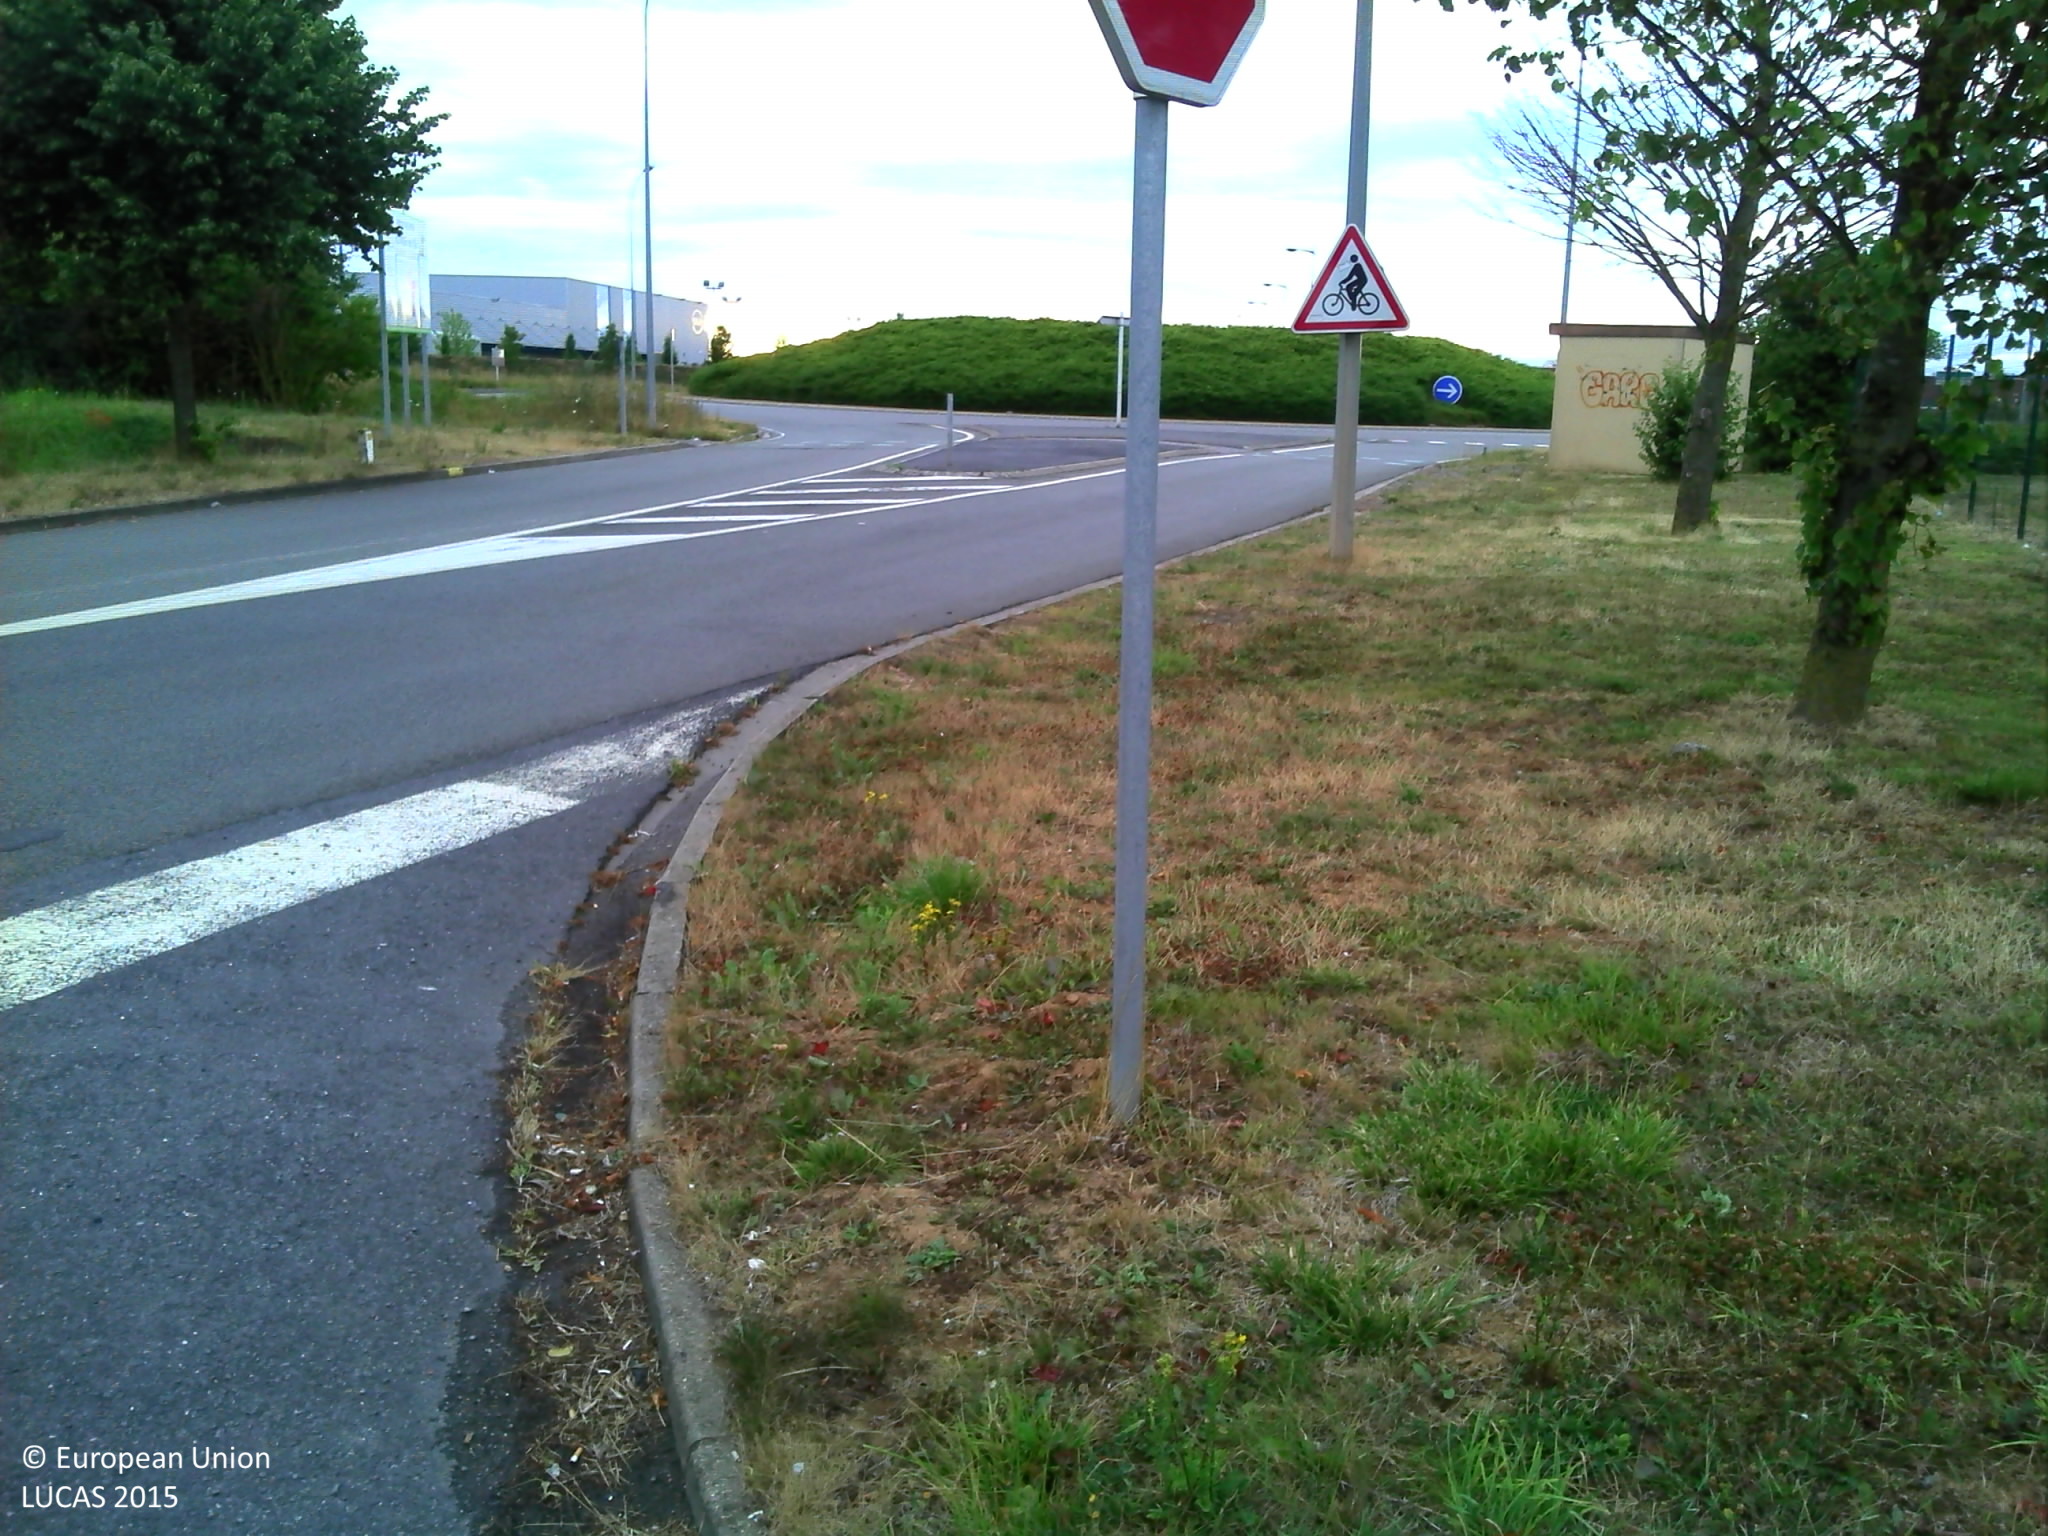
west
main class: Grassland
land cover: Grassland without tree/shrub cover
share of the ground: > 75 %
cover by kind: herbaceous plants 95 %, lichens and mosses 5 %
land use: Machinery and equipment
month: July
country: FR
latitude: 50.1975
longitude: 3.1968
